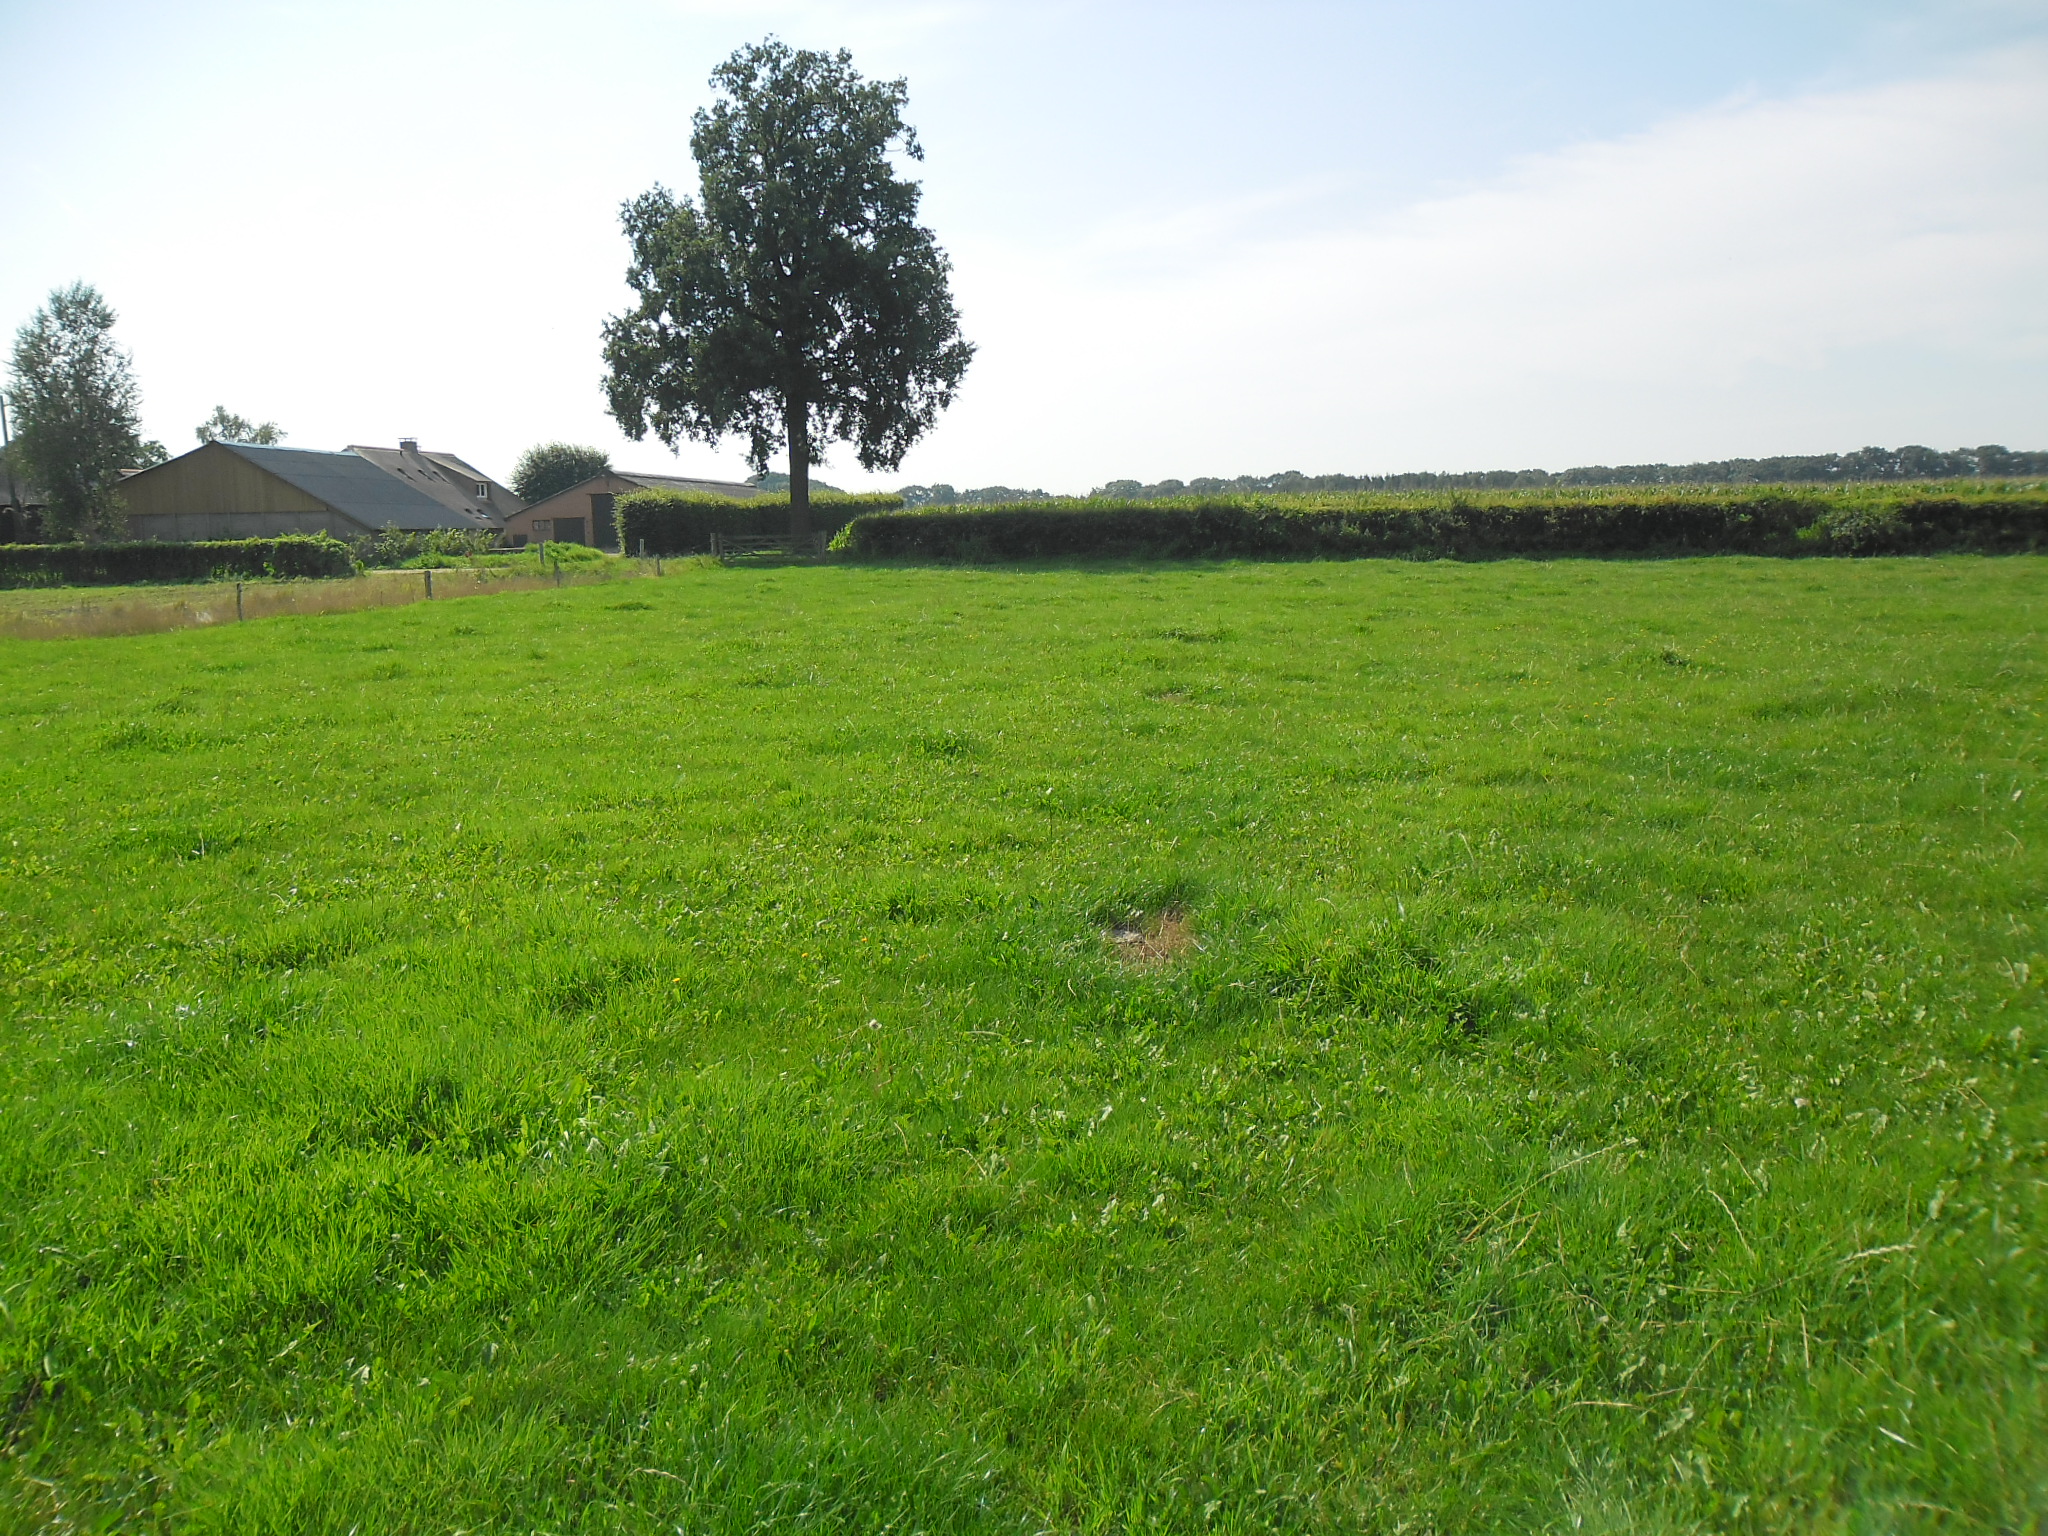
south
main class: Grassland
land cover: Grassland without tree/shrub cover
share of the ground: > 75 %
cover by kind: herbaceous plants 100 %
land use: Agriculture (excluding fallow land and kitchen gardens)
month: August
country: NL
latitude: 52.4603
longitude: 6.1876
